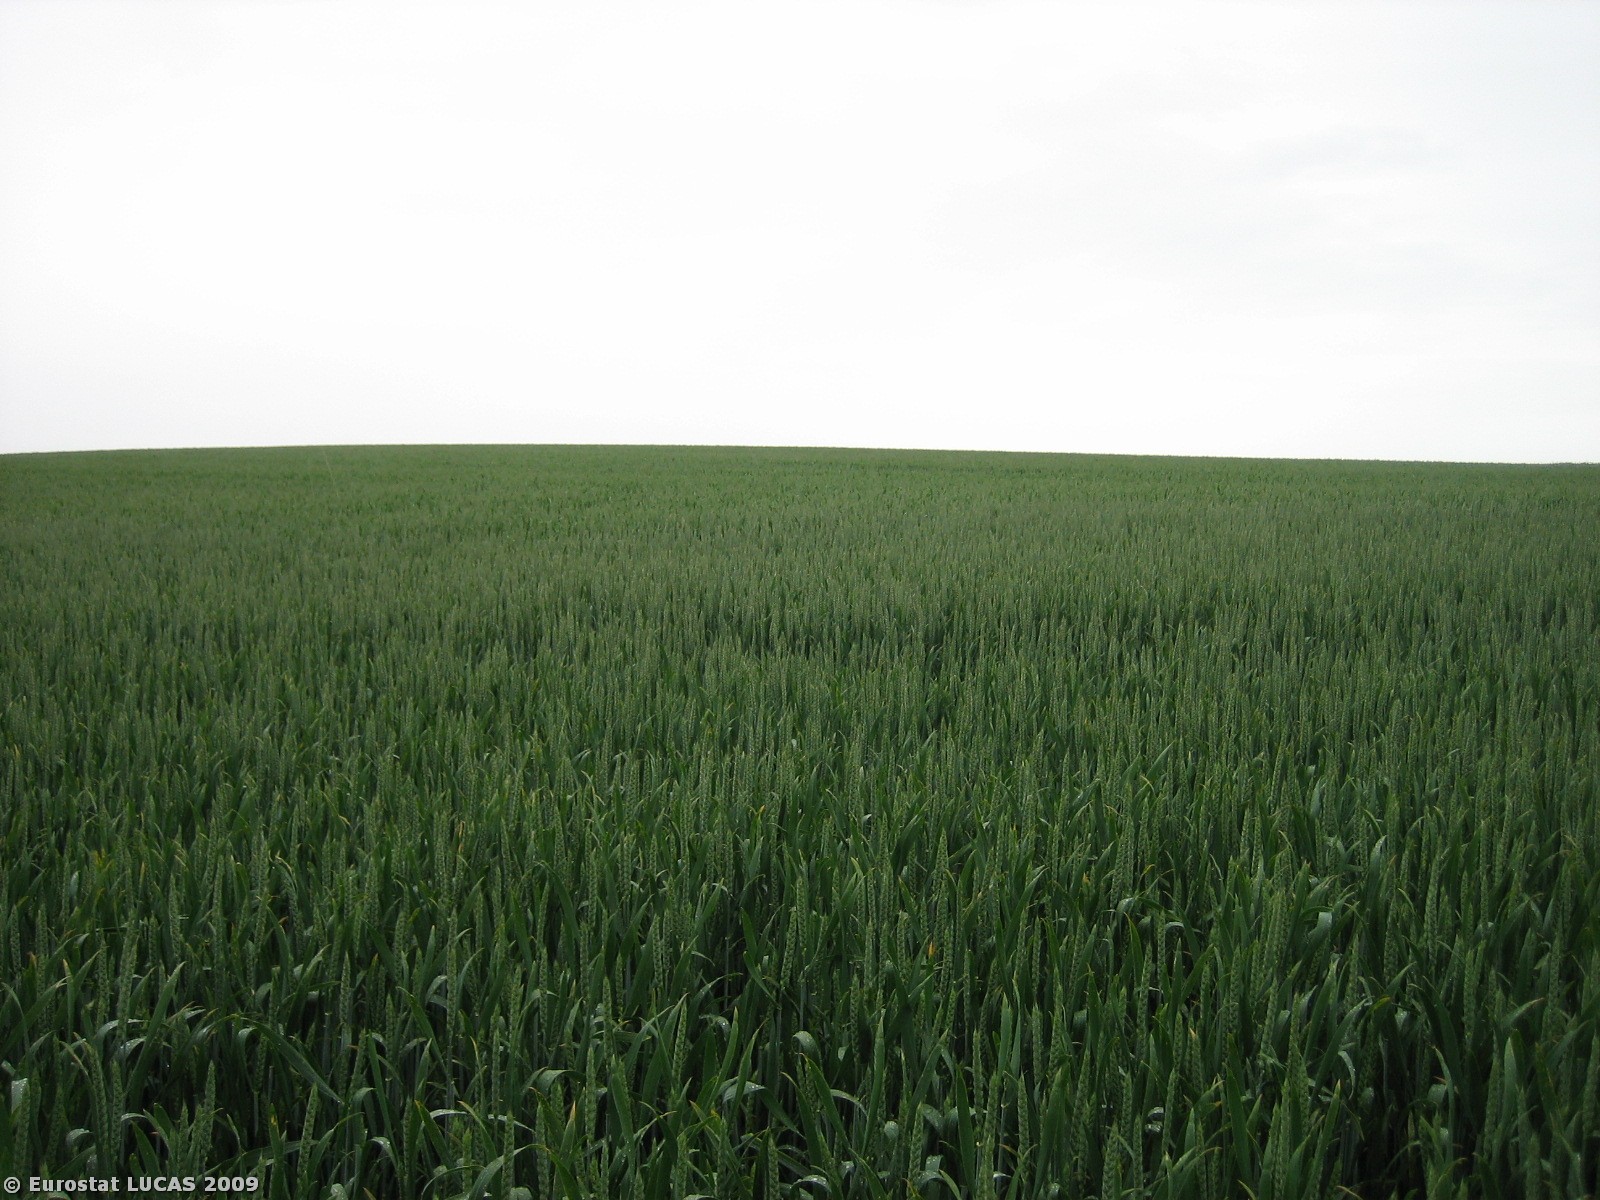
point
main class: Cropland
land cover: Common wheat
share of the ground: > 75 %
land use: Agriculture (excluding fallow land and kitchen gardens)
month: June
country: DK
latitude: 55.9540
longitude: 10.1440
